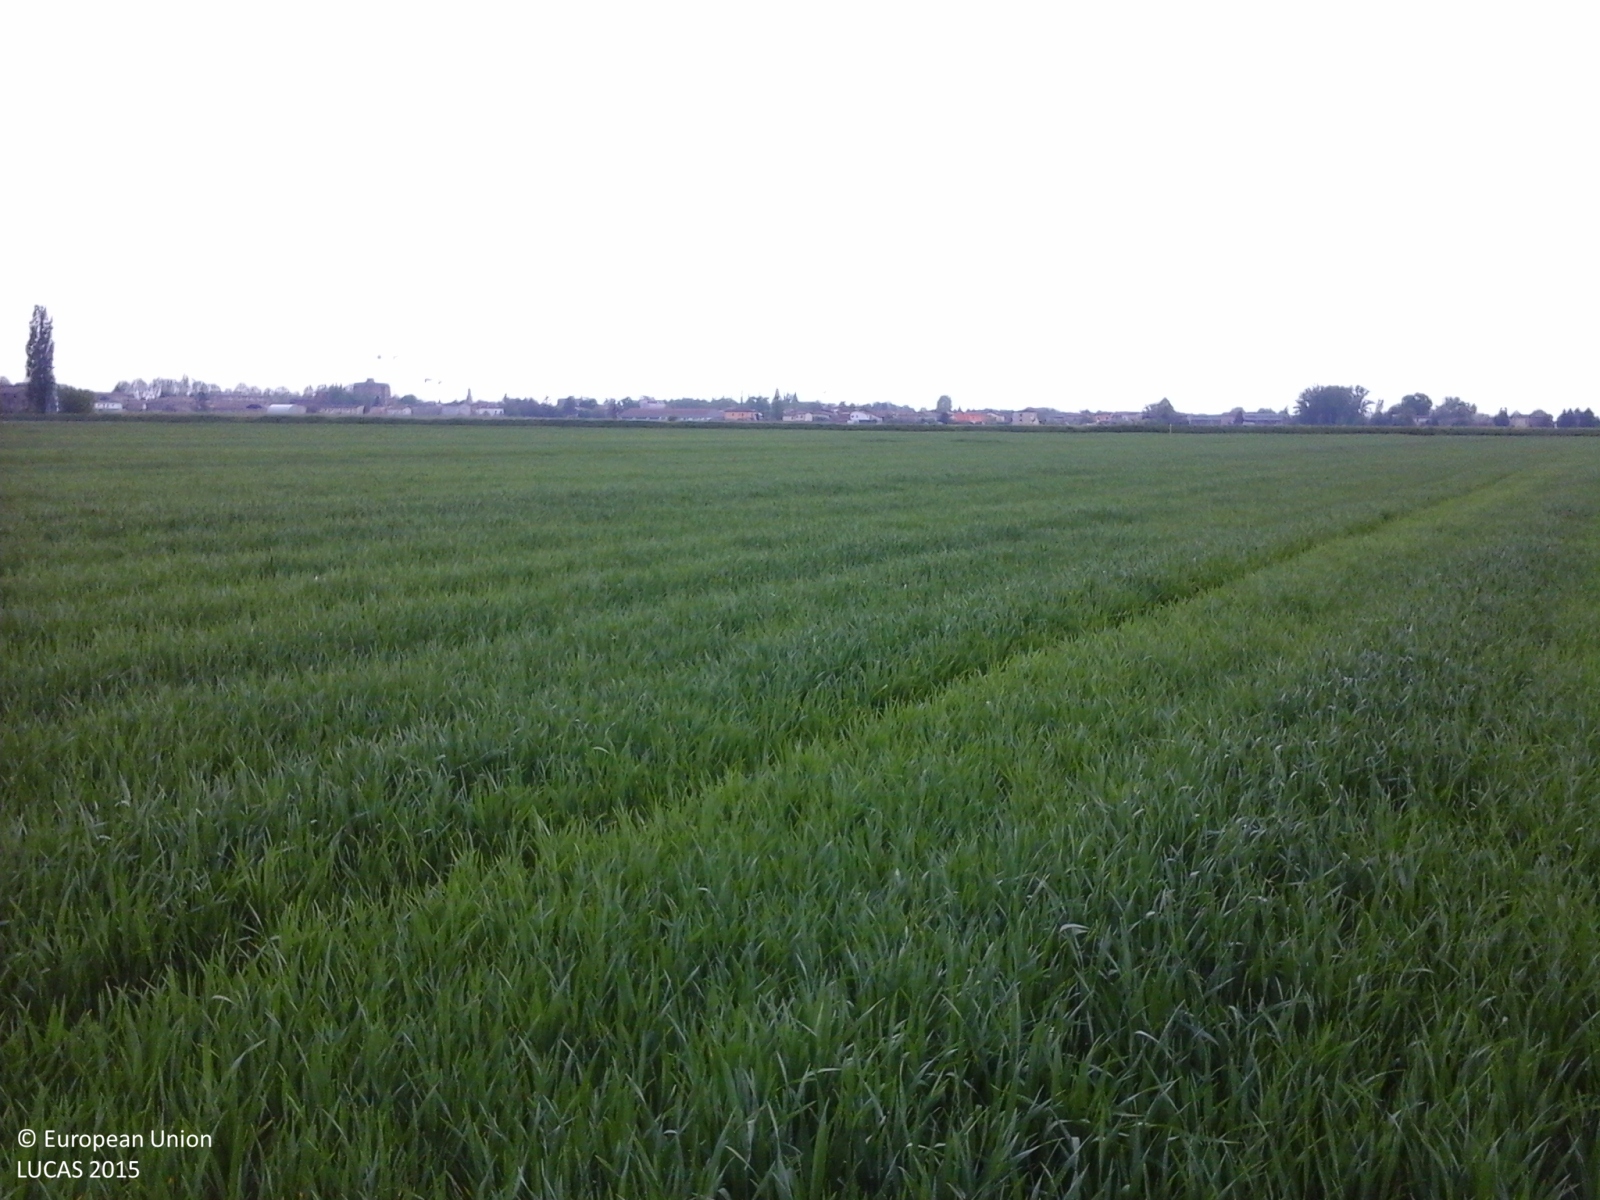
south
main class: Cropland
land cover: Common wheat
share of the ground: > 75 %
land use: Agriculture (excluding fallow land and kitchen gardens)
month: April
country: IT
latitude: 44.9057
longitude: 10.8974
